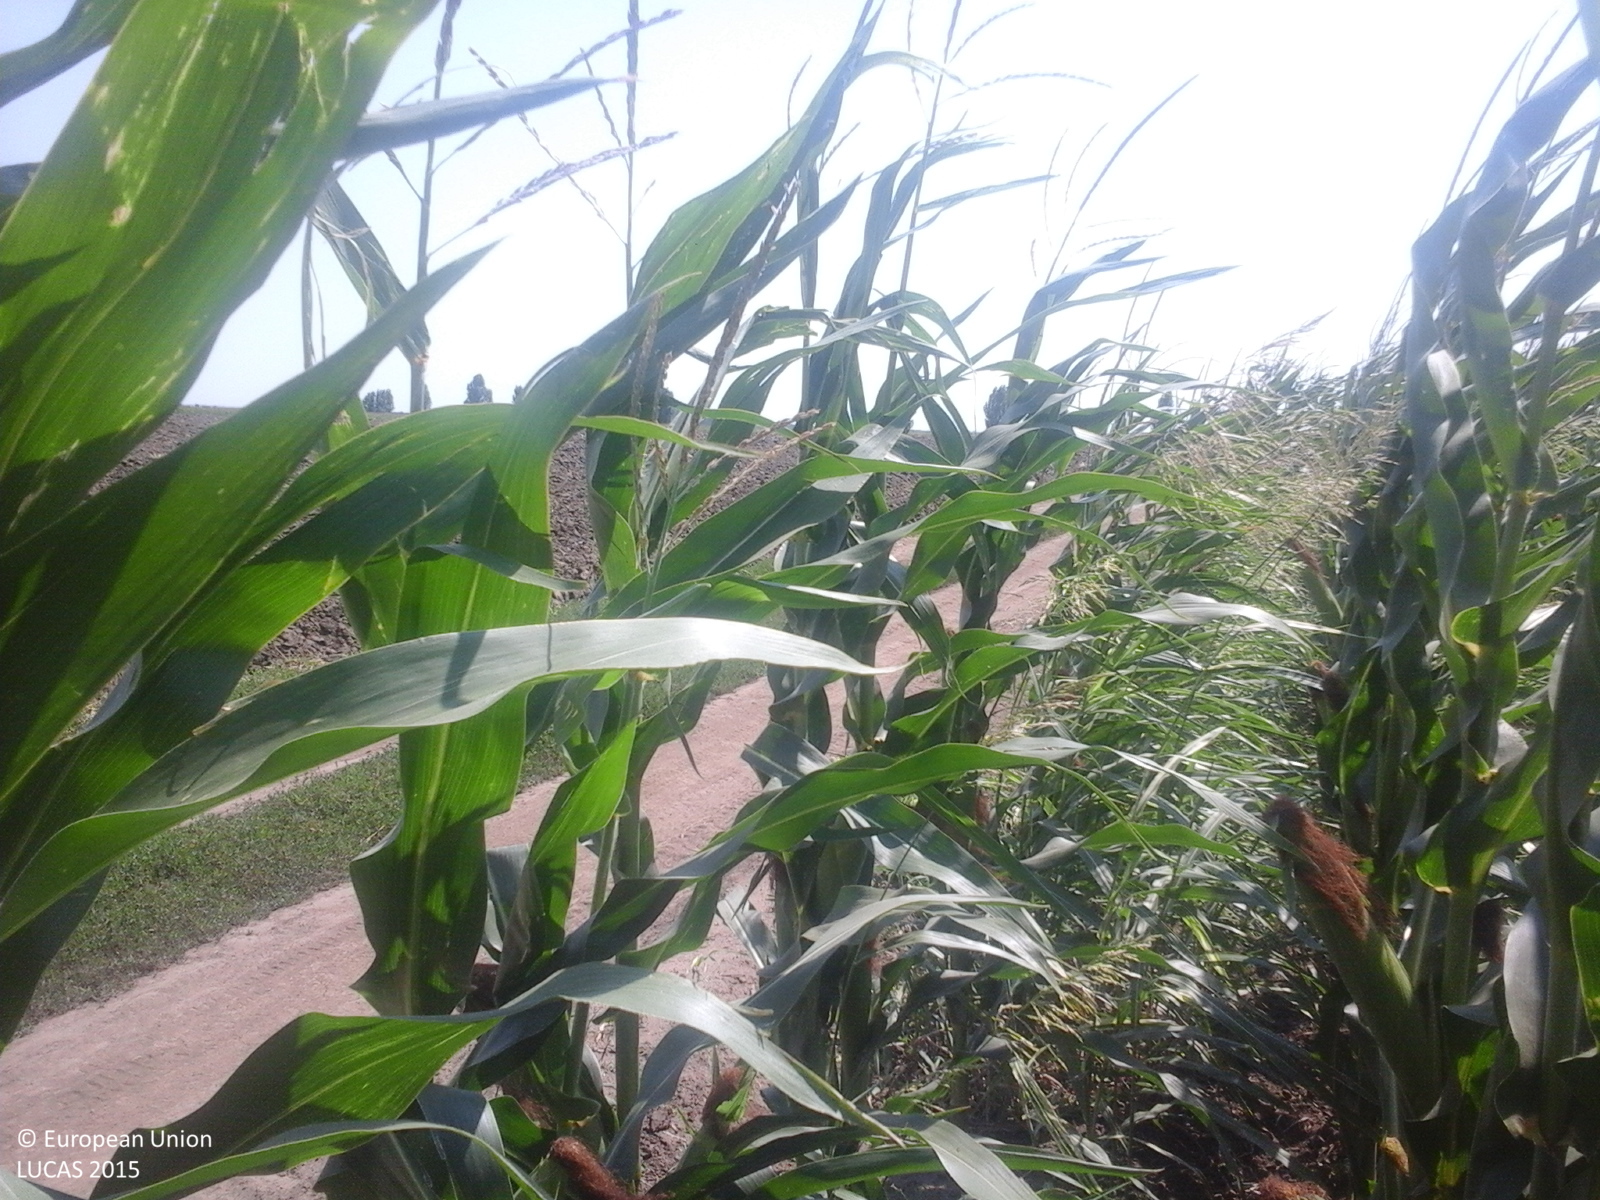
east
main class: Cropland
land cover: Maize
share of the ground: > 75 %
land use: Agriculture (excluding fallow land and kitchen gardens)
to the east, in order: Maize; Tracks; Barley
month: July
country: RO
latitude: 44.9101
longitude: 27.5130
